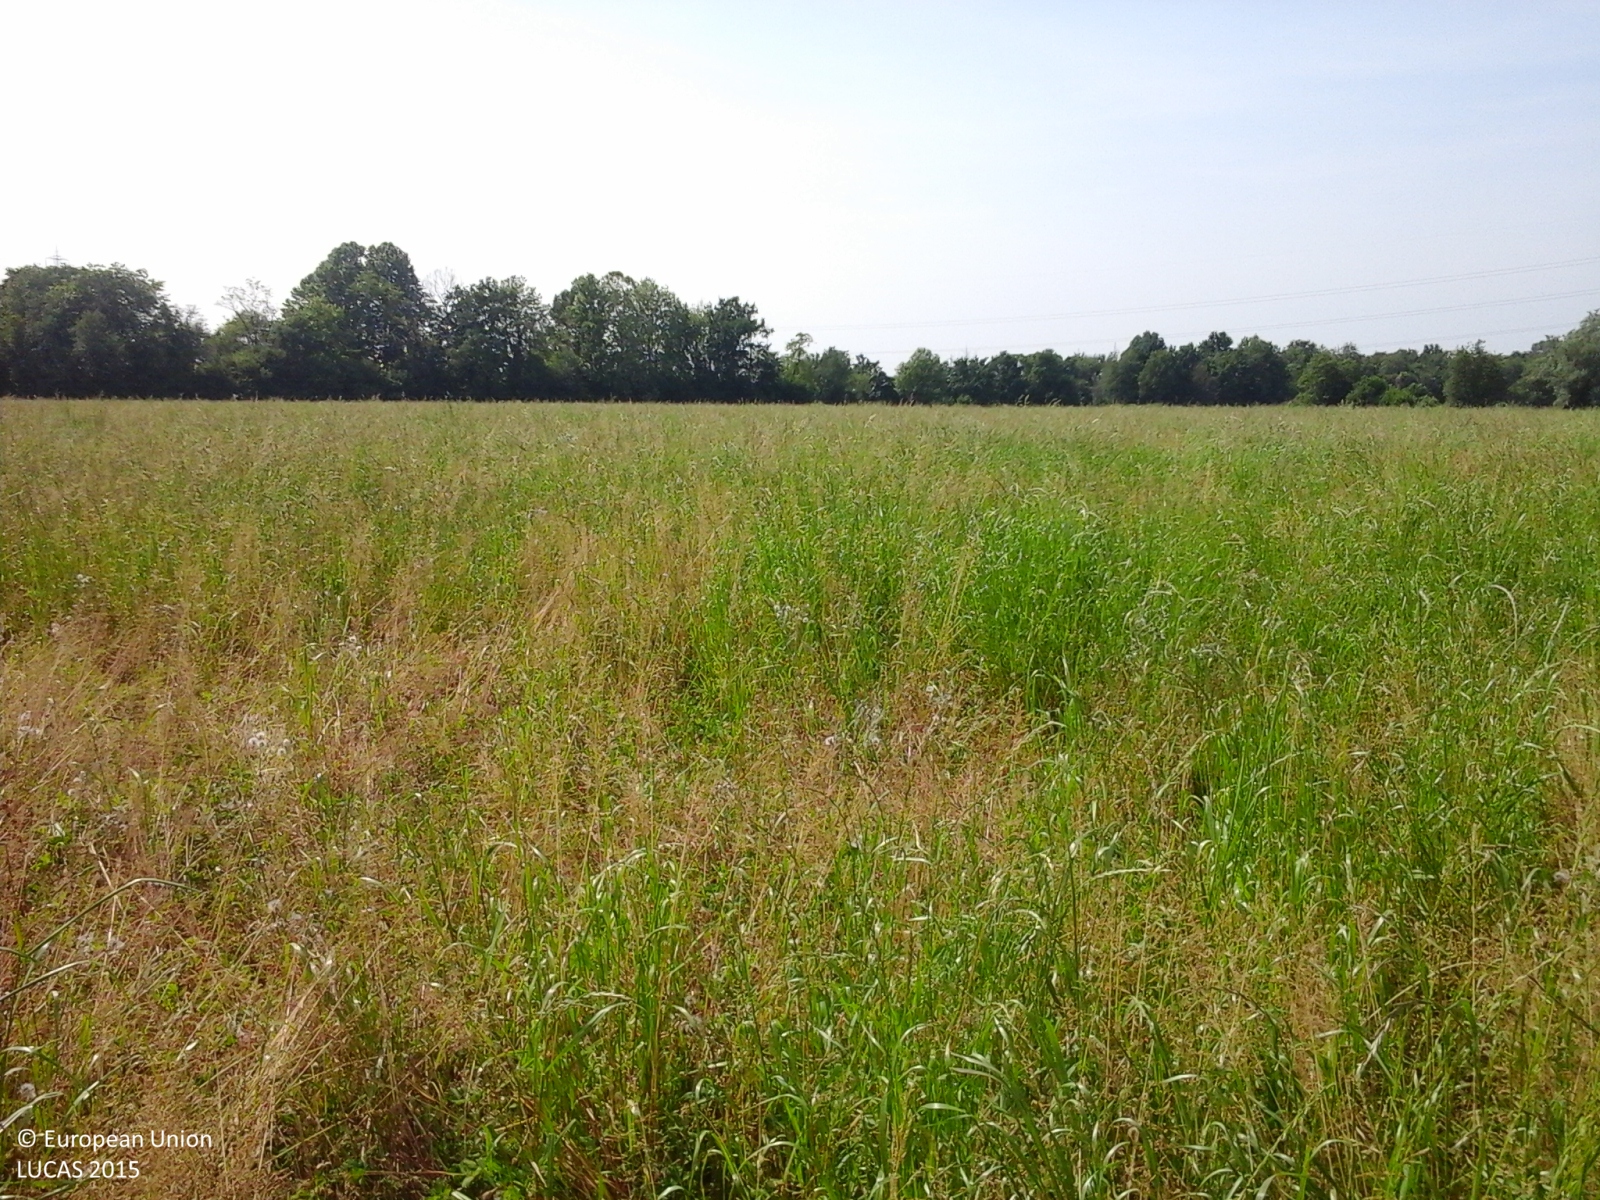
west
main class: Grassland
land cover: Spontaneously vegetated surfaces
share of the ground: > 75 %
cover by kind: herbaceous plants 100 %
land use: Agriculture (excluding fallow land and kitchen gardens)
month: May
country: IT
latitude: 45.4485
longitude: 9.3746
